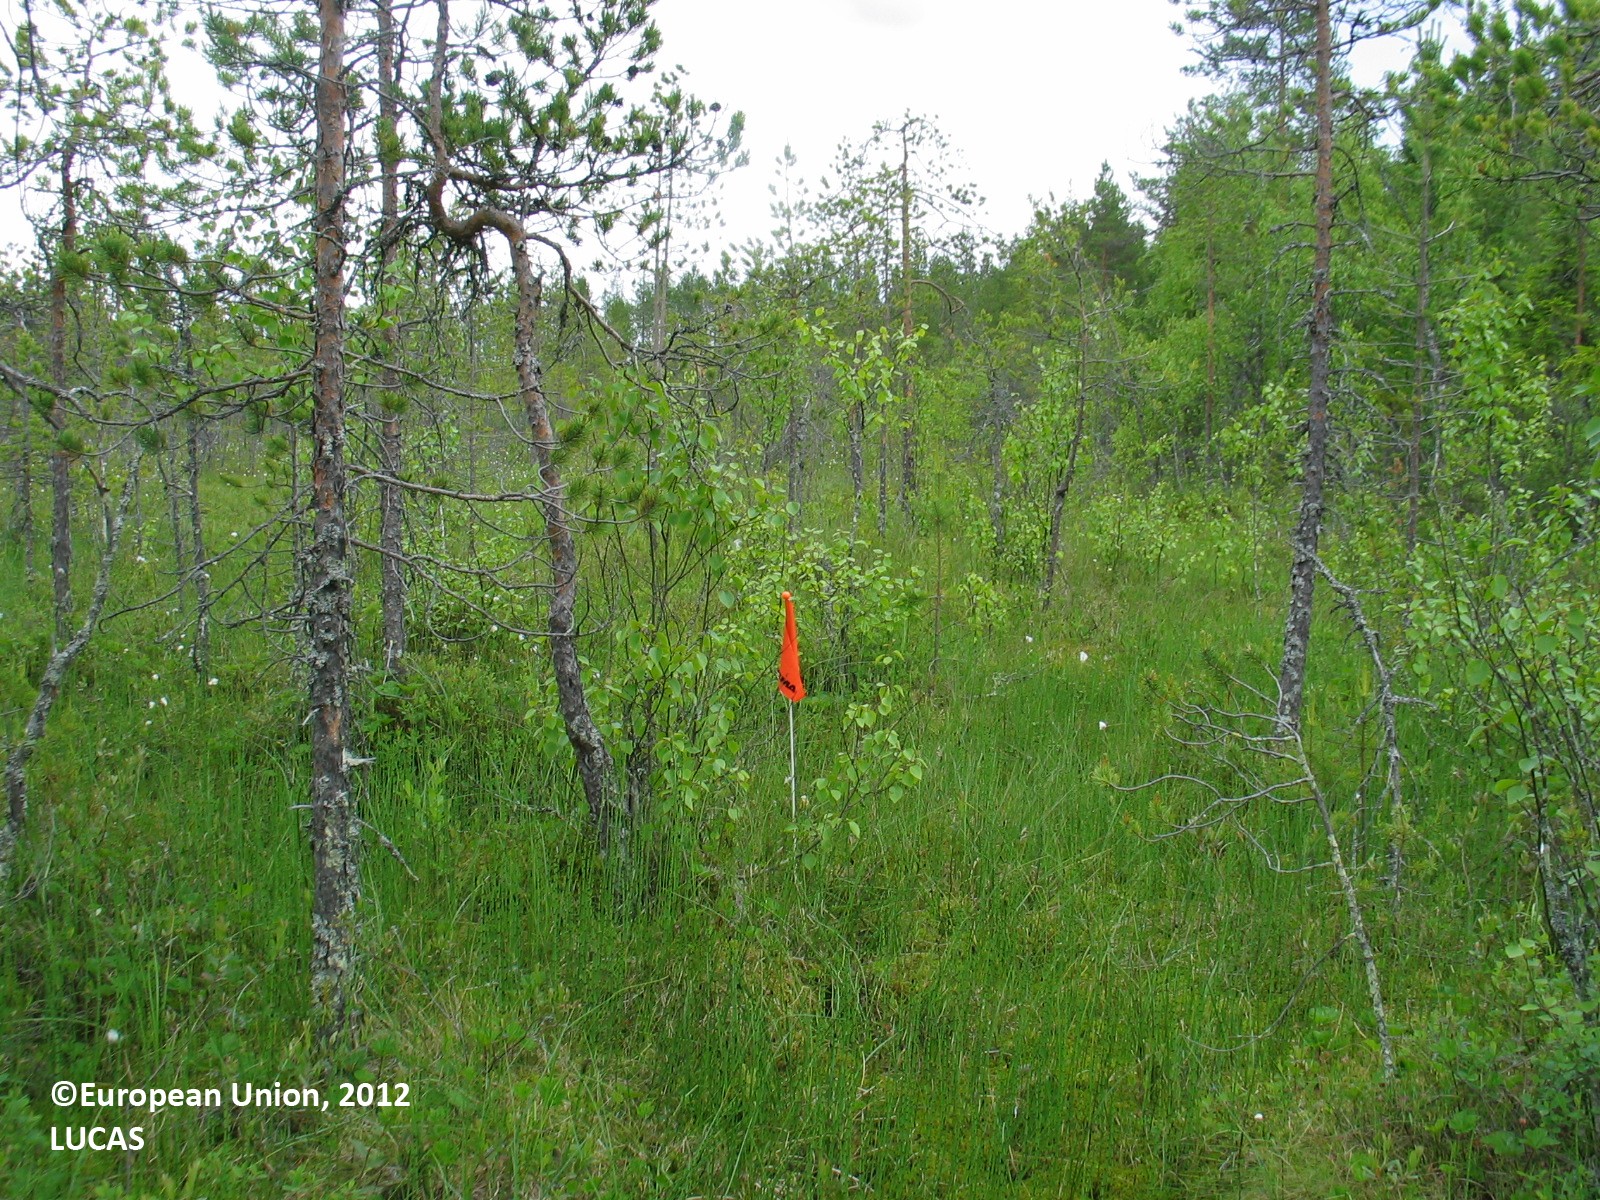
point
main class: Woodland
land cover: Pine dominated coniferous woodland
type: mire and swamp forests
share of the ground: 10 - 25 %
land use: Semi-natural and natural areas not in use
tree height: > 5 m
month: June
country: FI
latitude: 64.8653
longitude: 26.6351
